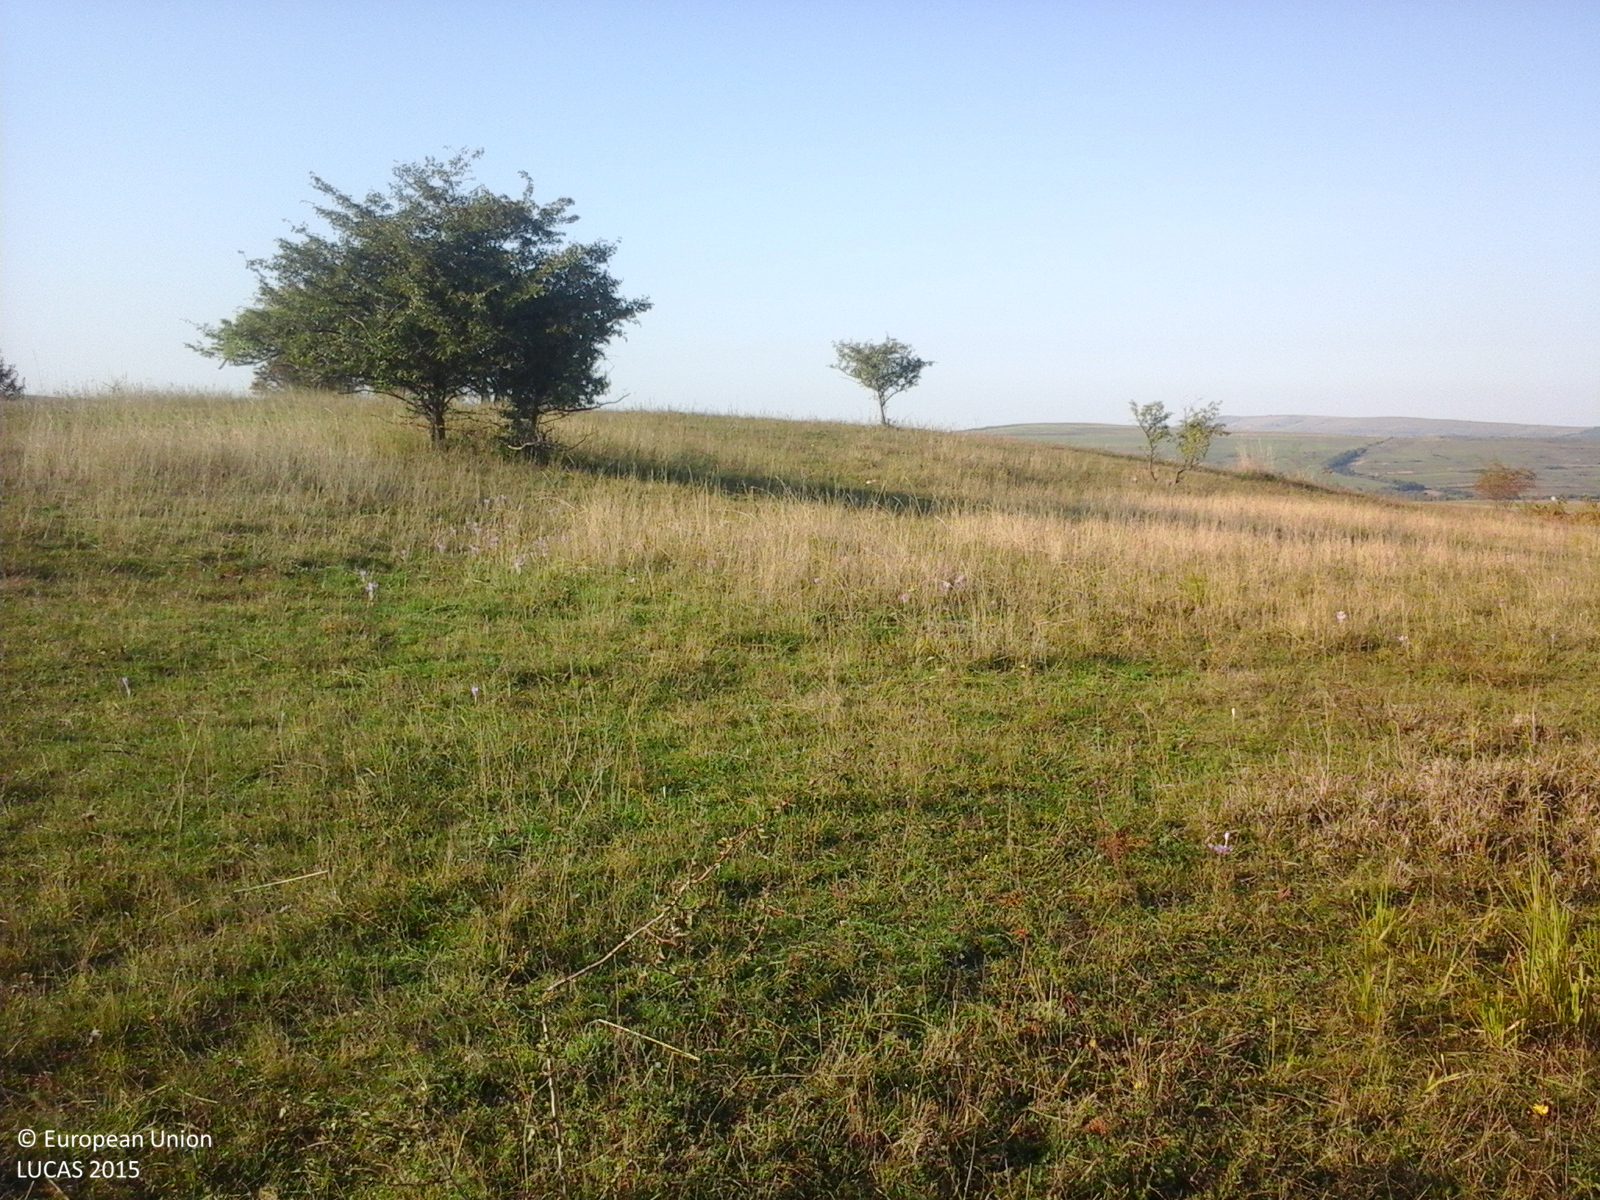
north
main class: Grassland
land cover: Grassland with sparse tree/shrub cover
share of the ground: > 75 %
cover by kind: herbaceous plants 85 %, shrubs 10 %, broadleaved forest trees 5 %
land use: Agriculture (excluding fallow land and kitchen gardens)
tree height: < 5 m
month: October
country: RO
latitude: 46.6036
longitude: 23.5021
